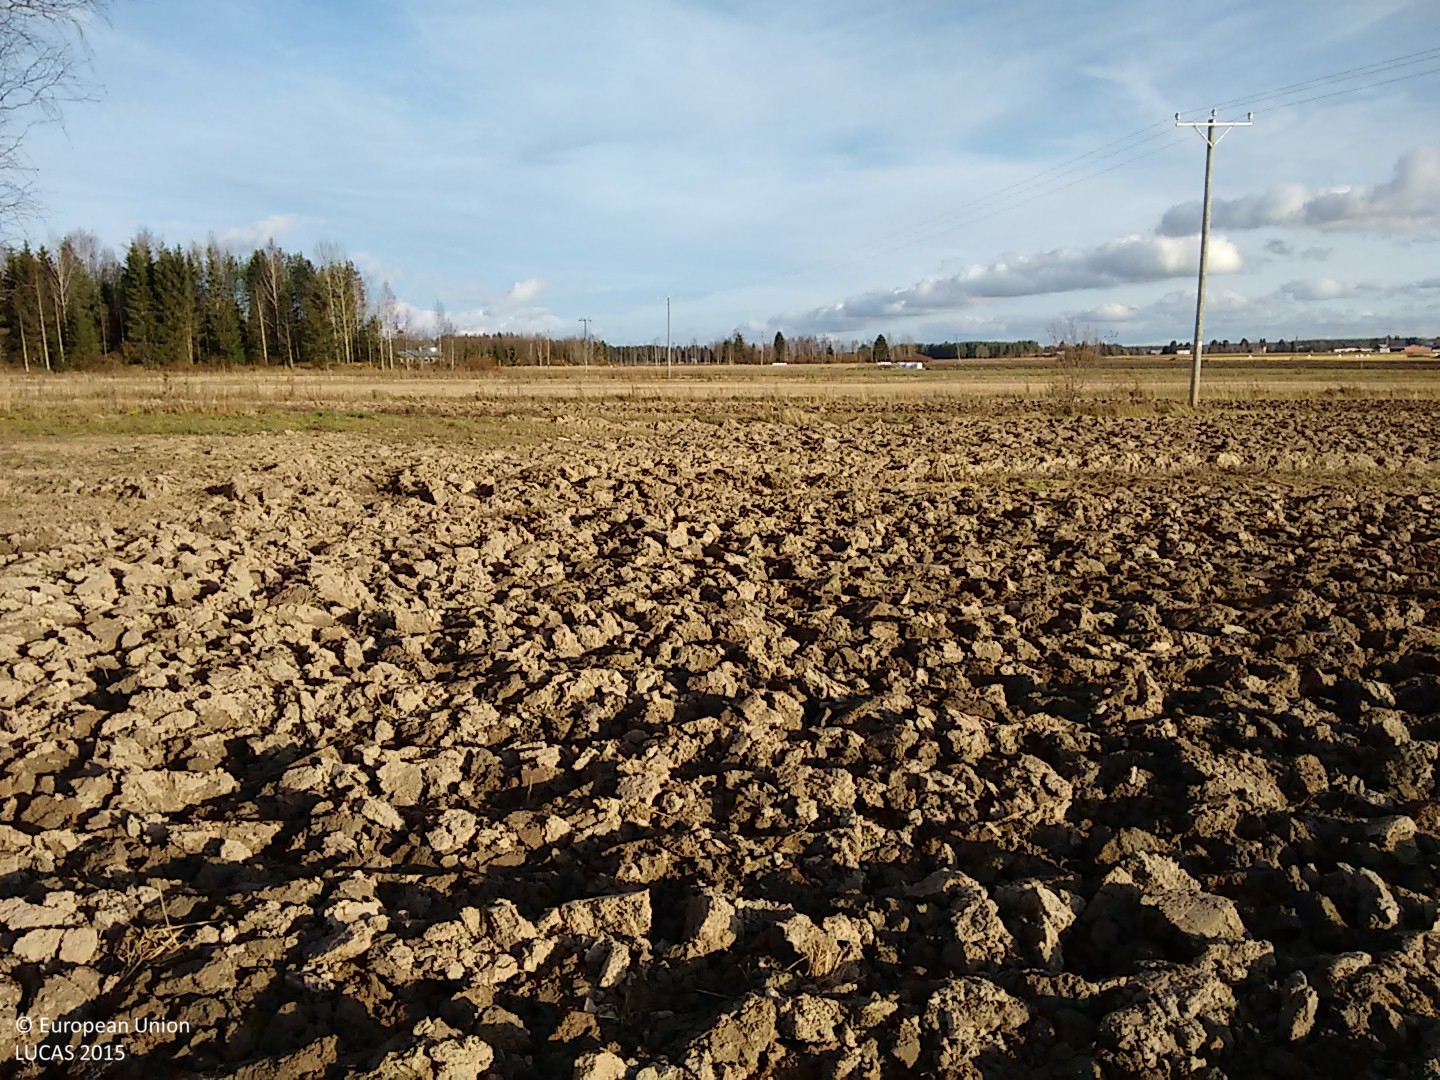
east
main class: Cropland
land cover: Barley
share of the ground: < 10 %
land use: Agriculture (excluding fallow land and kitchen gardens)
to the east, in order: Barley; Ditches and canals; Grass margins; Barley; Tracks; Ditches and canals; Barley; Grass margins; Ditches and canals; Grass margins; Barley; Shruby margins; Ditches and canals; Shruby margins; Barley; Grass margins; Ditches and canals; Grass margins; Barley; Electric lines; Barley; Tracks; Shruby margins; Ditches and canals; Grass margins; Fences; Grassland without tree/shrub cover
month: October
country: FI
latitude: 63.9615
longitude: 25.1360
